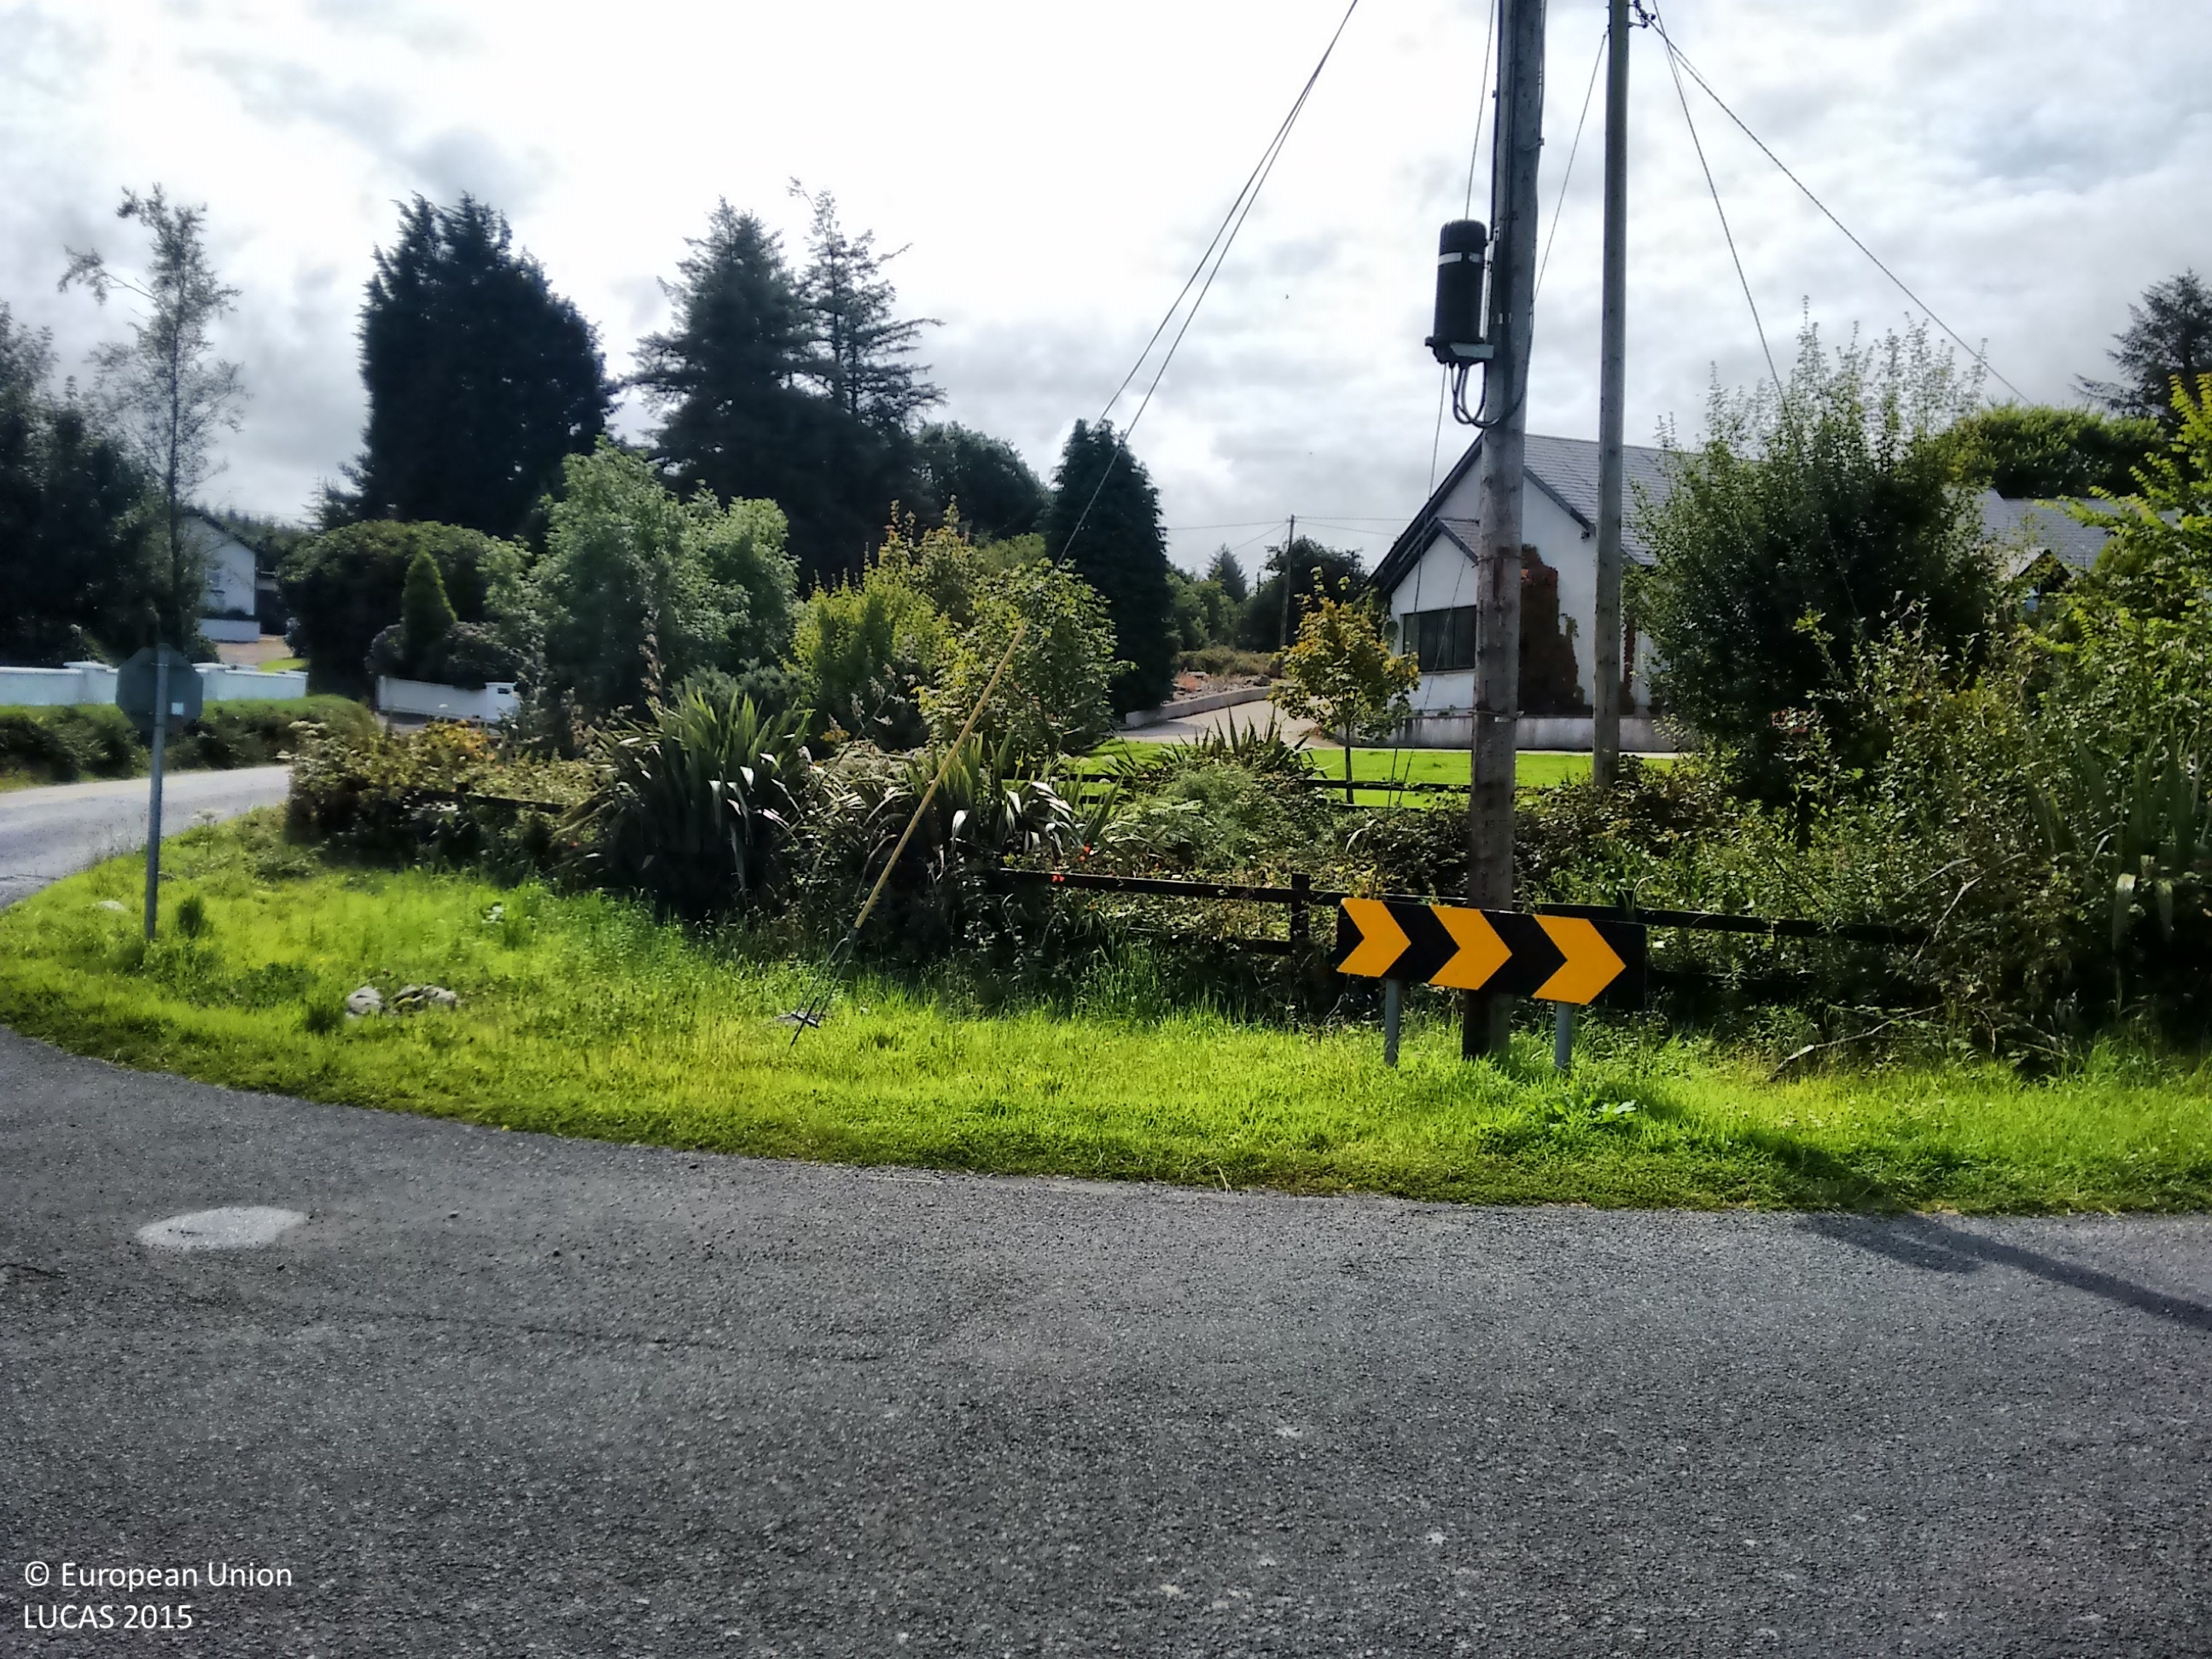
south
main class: Shrubland
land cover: Shrubland with sparse tree cover
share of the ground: > 75 %
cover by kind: shrubs 95 %, broadleaved forest trees 5 %
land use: Residential
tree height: > 5 m
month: August
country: IE
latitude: 52.3211
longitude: -6.5766
